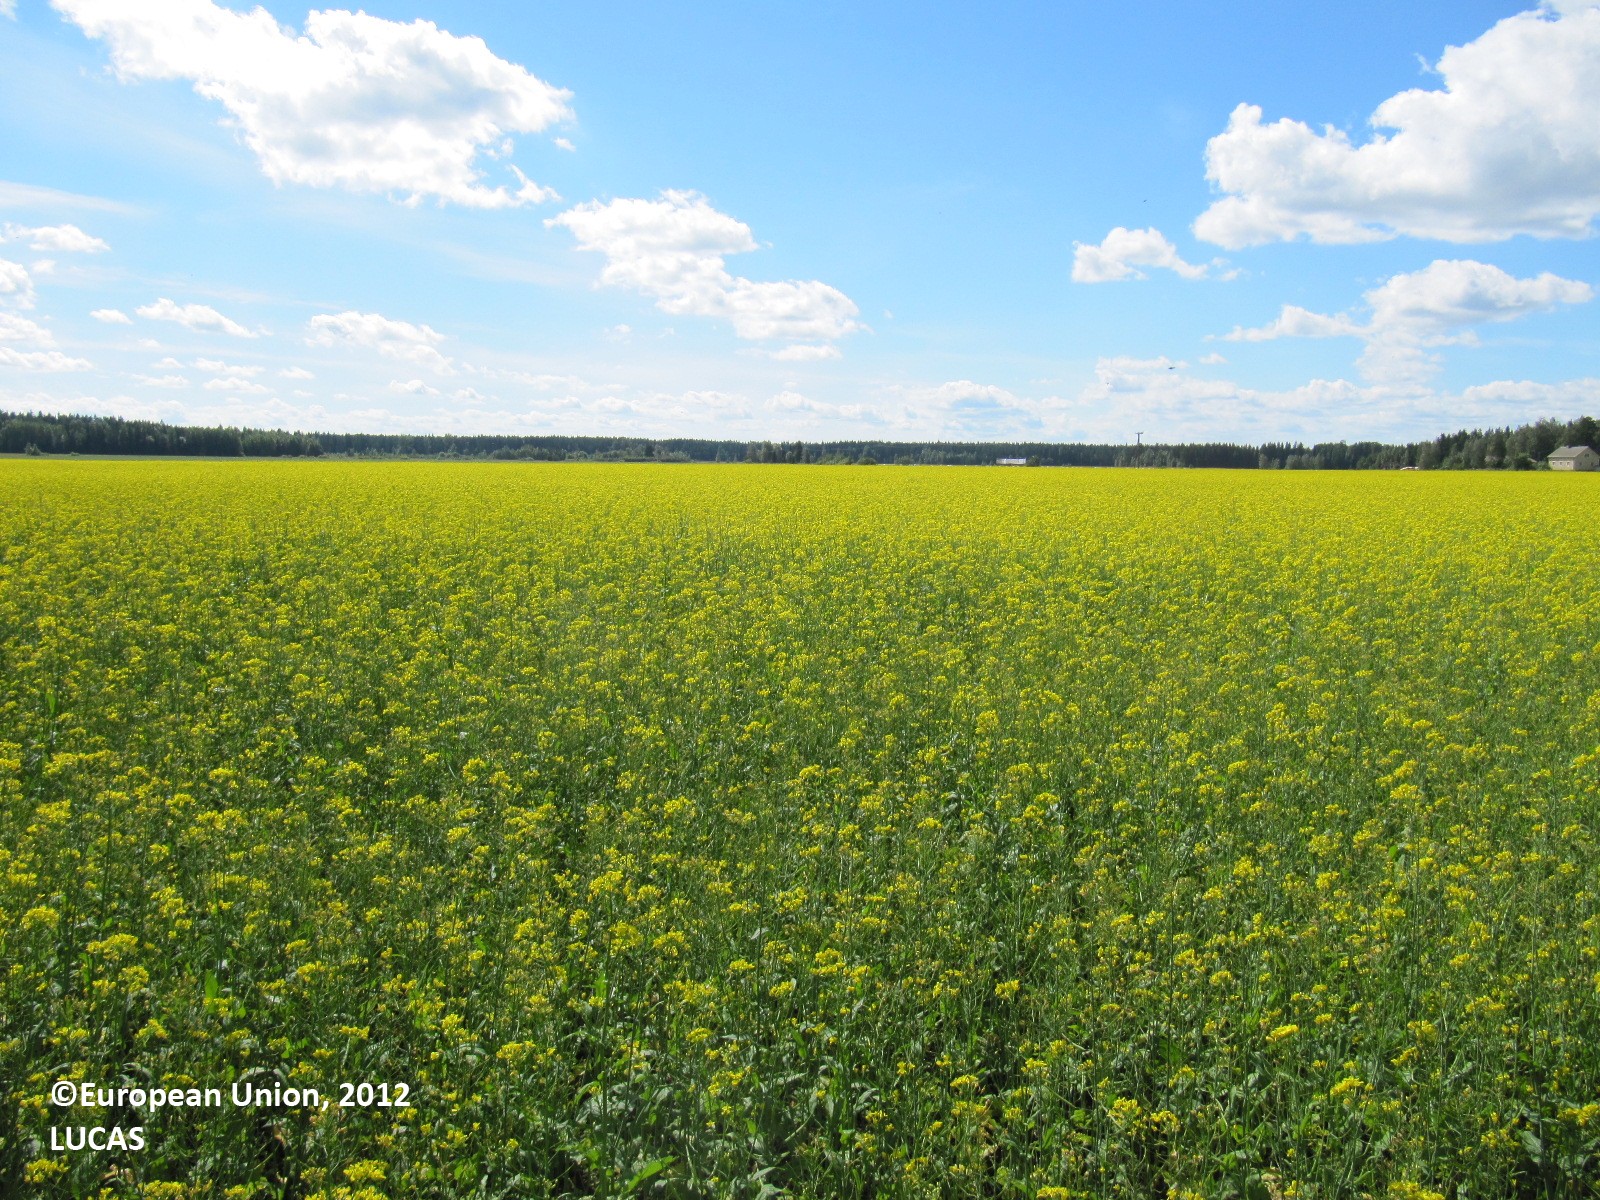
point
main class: Cropland
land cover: Rape and turnip rape
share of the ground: > 75 %
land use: Agriculture (excluding fallow land and kitchen gardens)
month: August
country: FI
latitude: 60.6338
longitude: 23.2249
